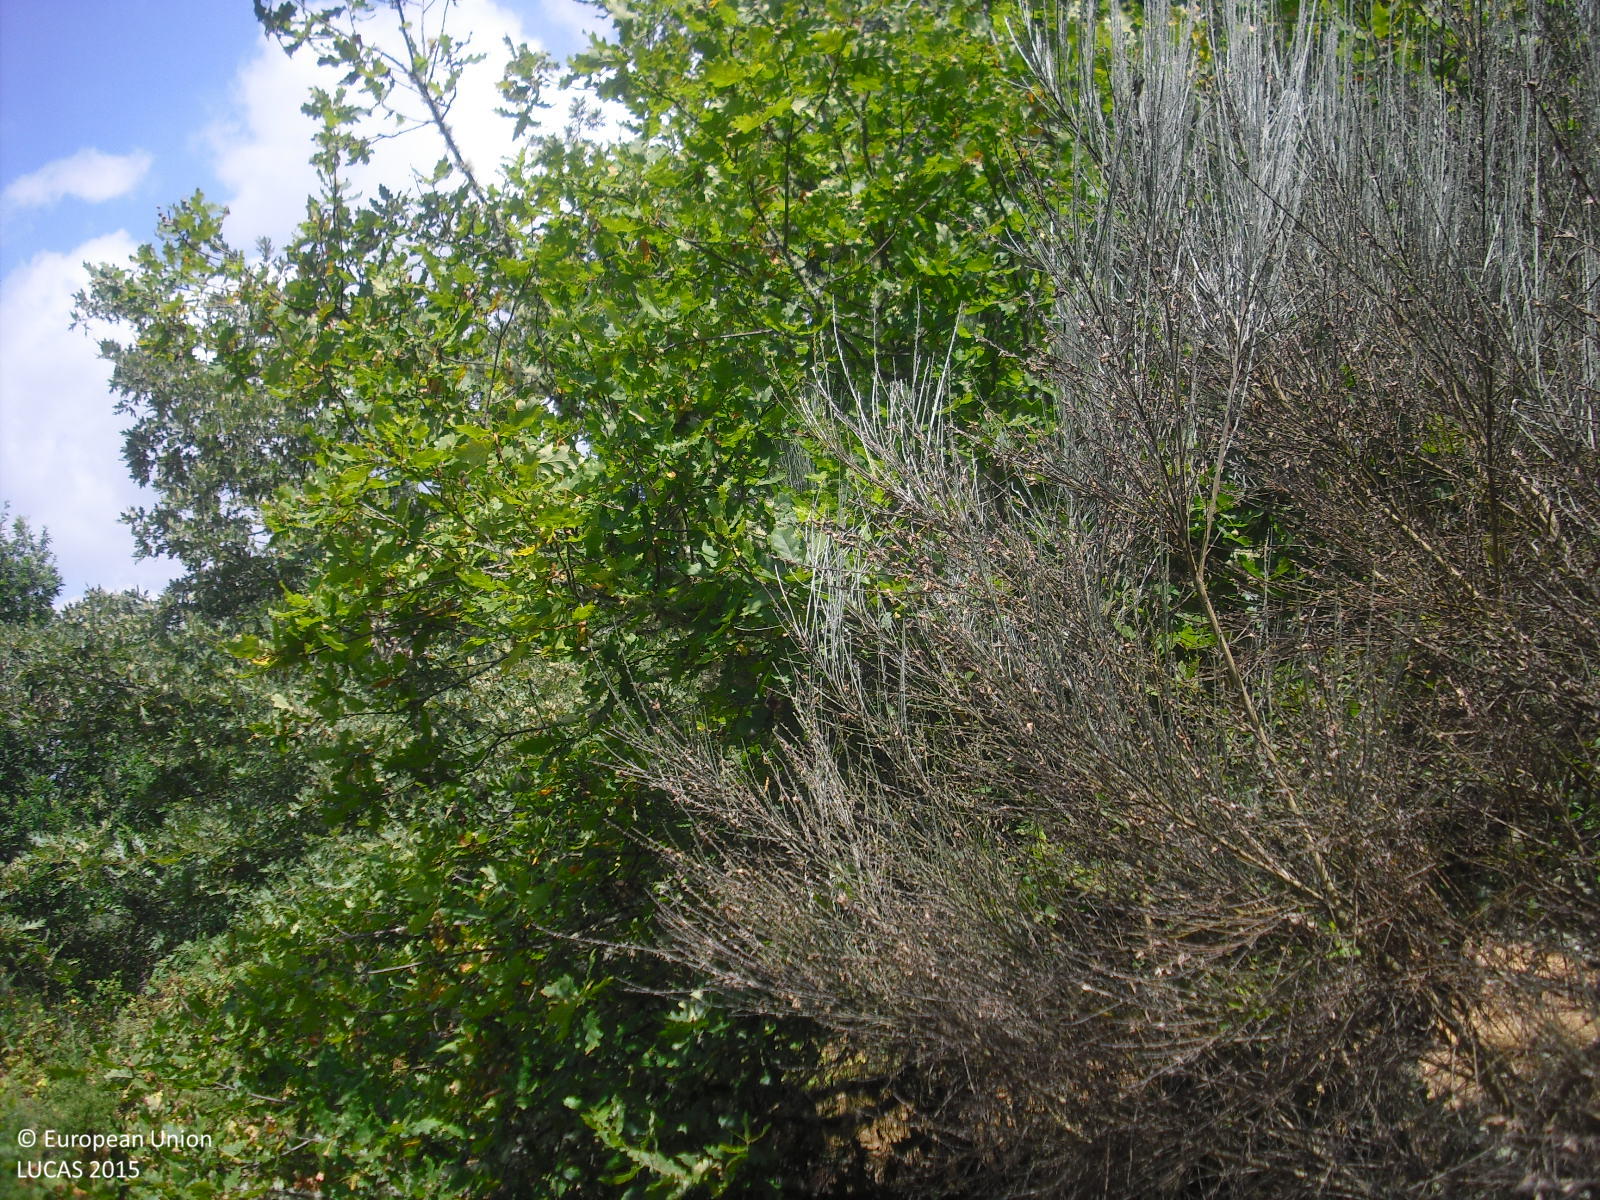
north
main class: Woodland
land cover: Broadleaved woodland
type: thermophilous deciduous forest
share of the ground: 25 - 50 %
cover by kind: shrubs 60 %, broadleaved forest trees 30 %, herbaceous plants 10 %
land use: Semi-natural and natural areas not in use
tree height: > 5 m
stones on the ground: < 10 %
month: July
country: ES
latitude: 42.3509
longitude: -7.7120
